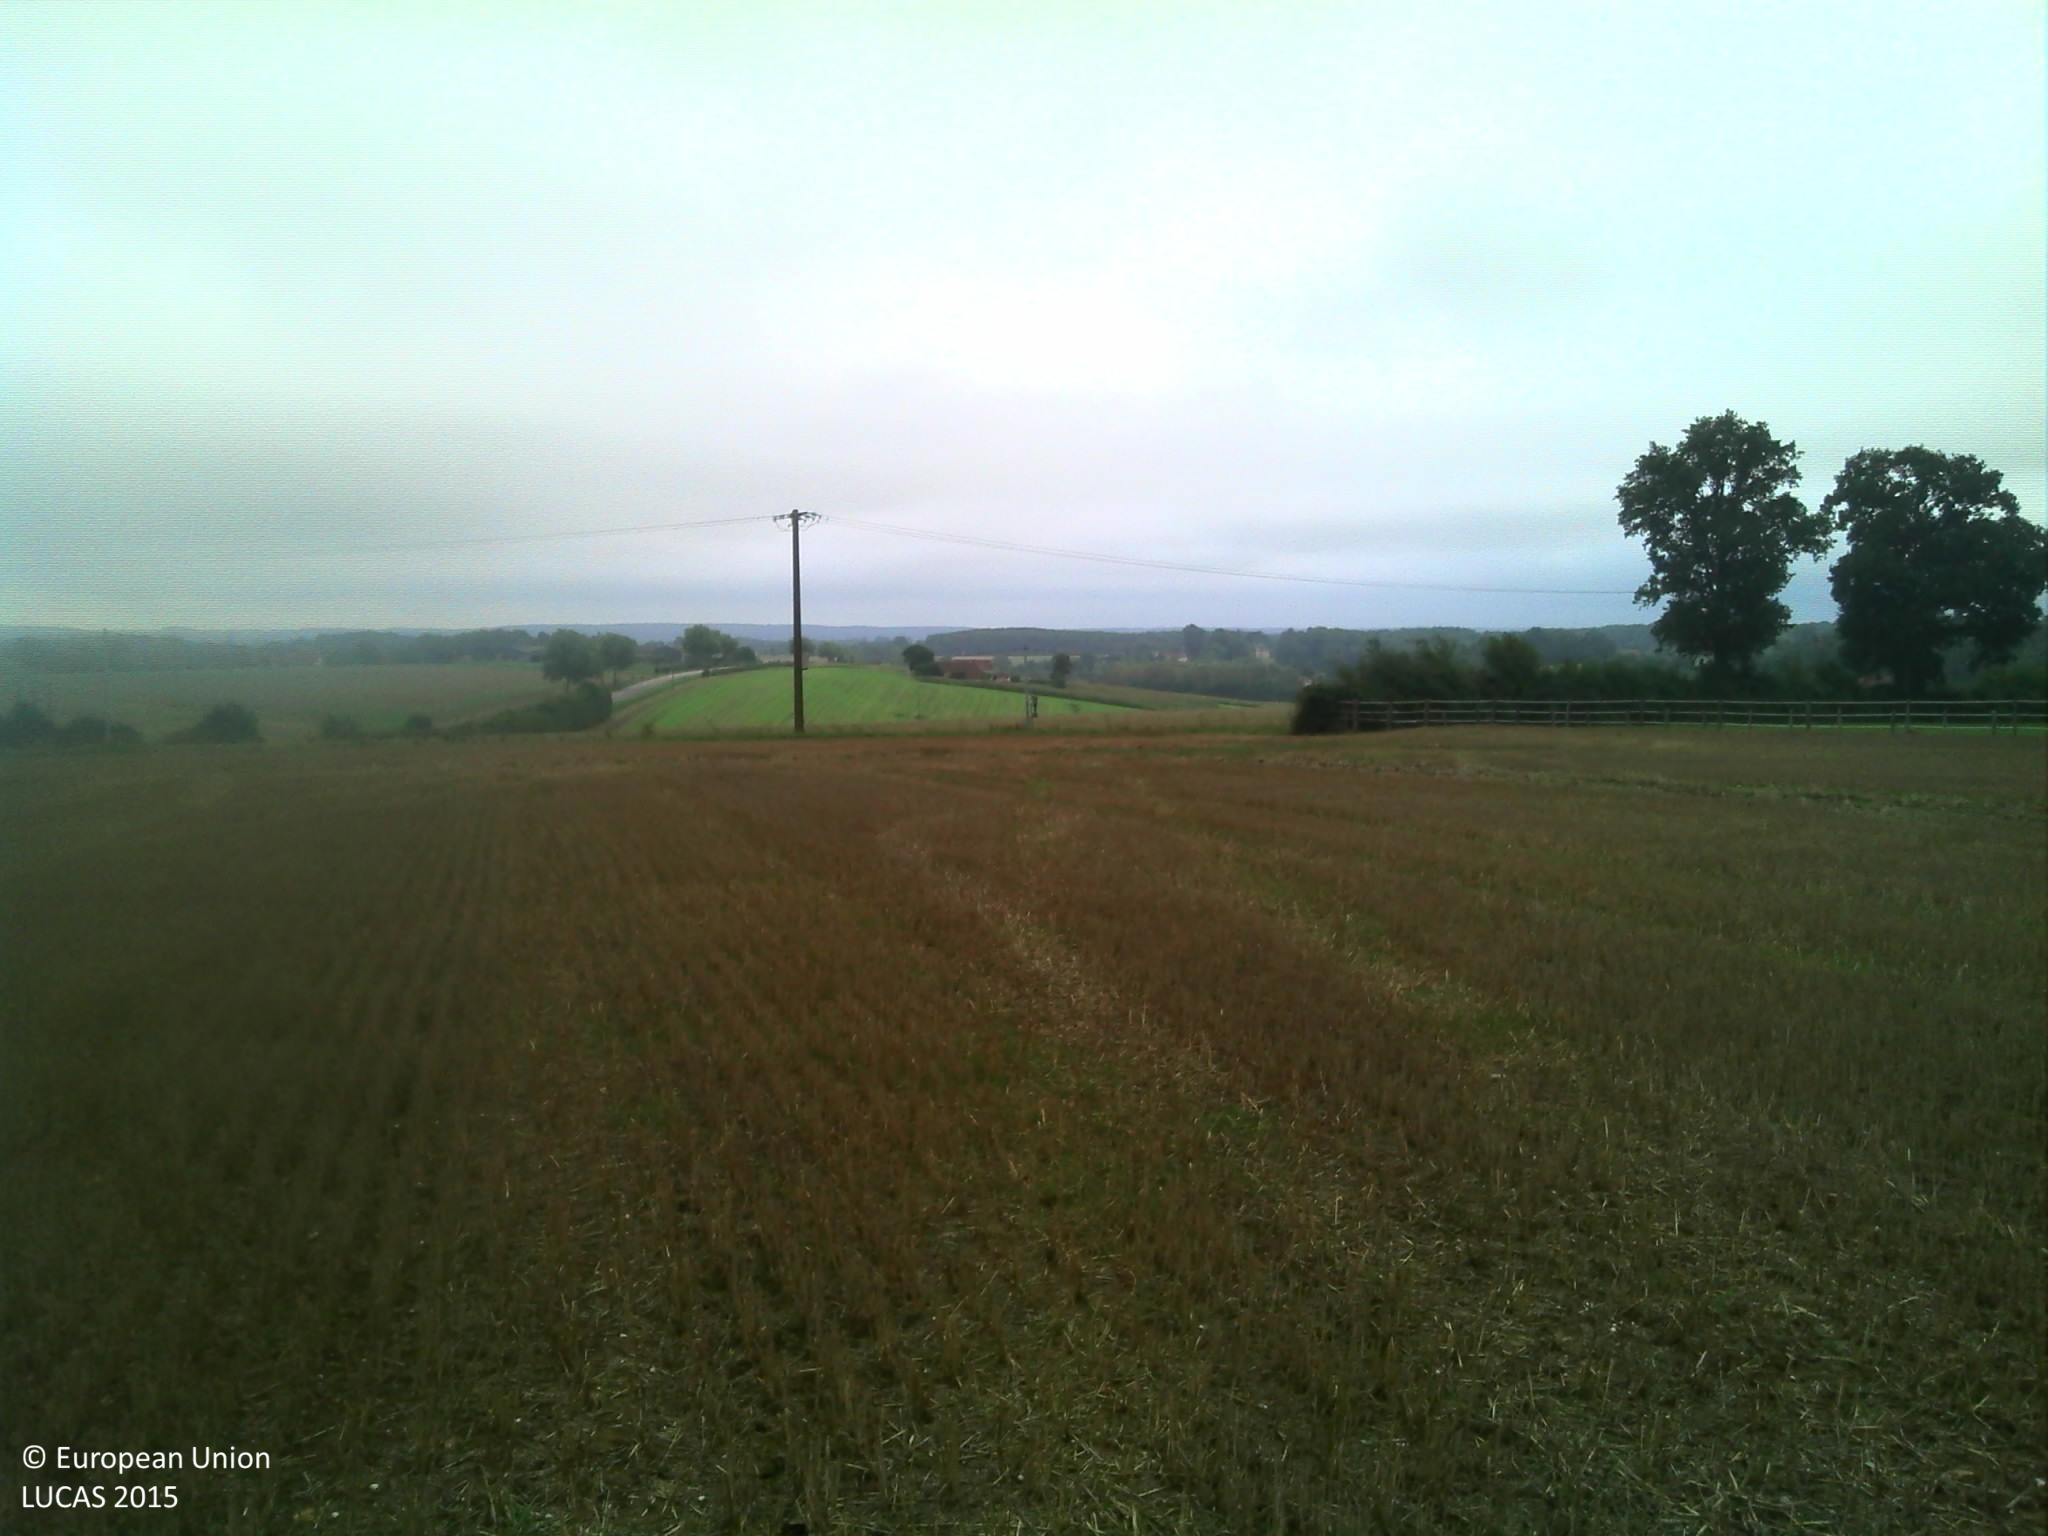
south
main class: Cropland
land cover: Common wheat
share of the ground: < 10 %
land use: Agriculture (excluding fallow land and kitchen gardens)
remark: Harvested field
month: August
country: FR
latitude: 48.4866
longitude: 0.5451
